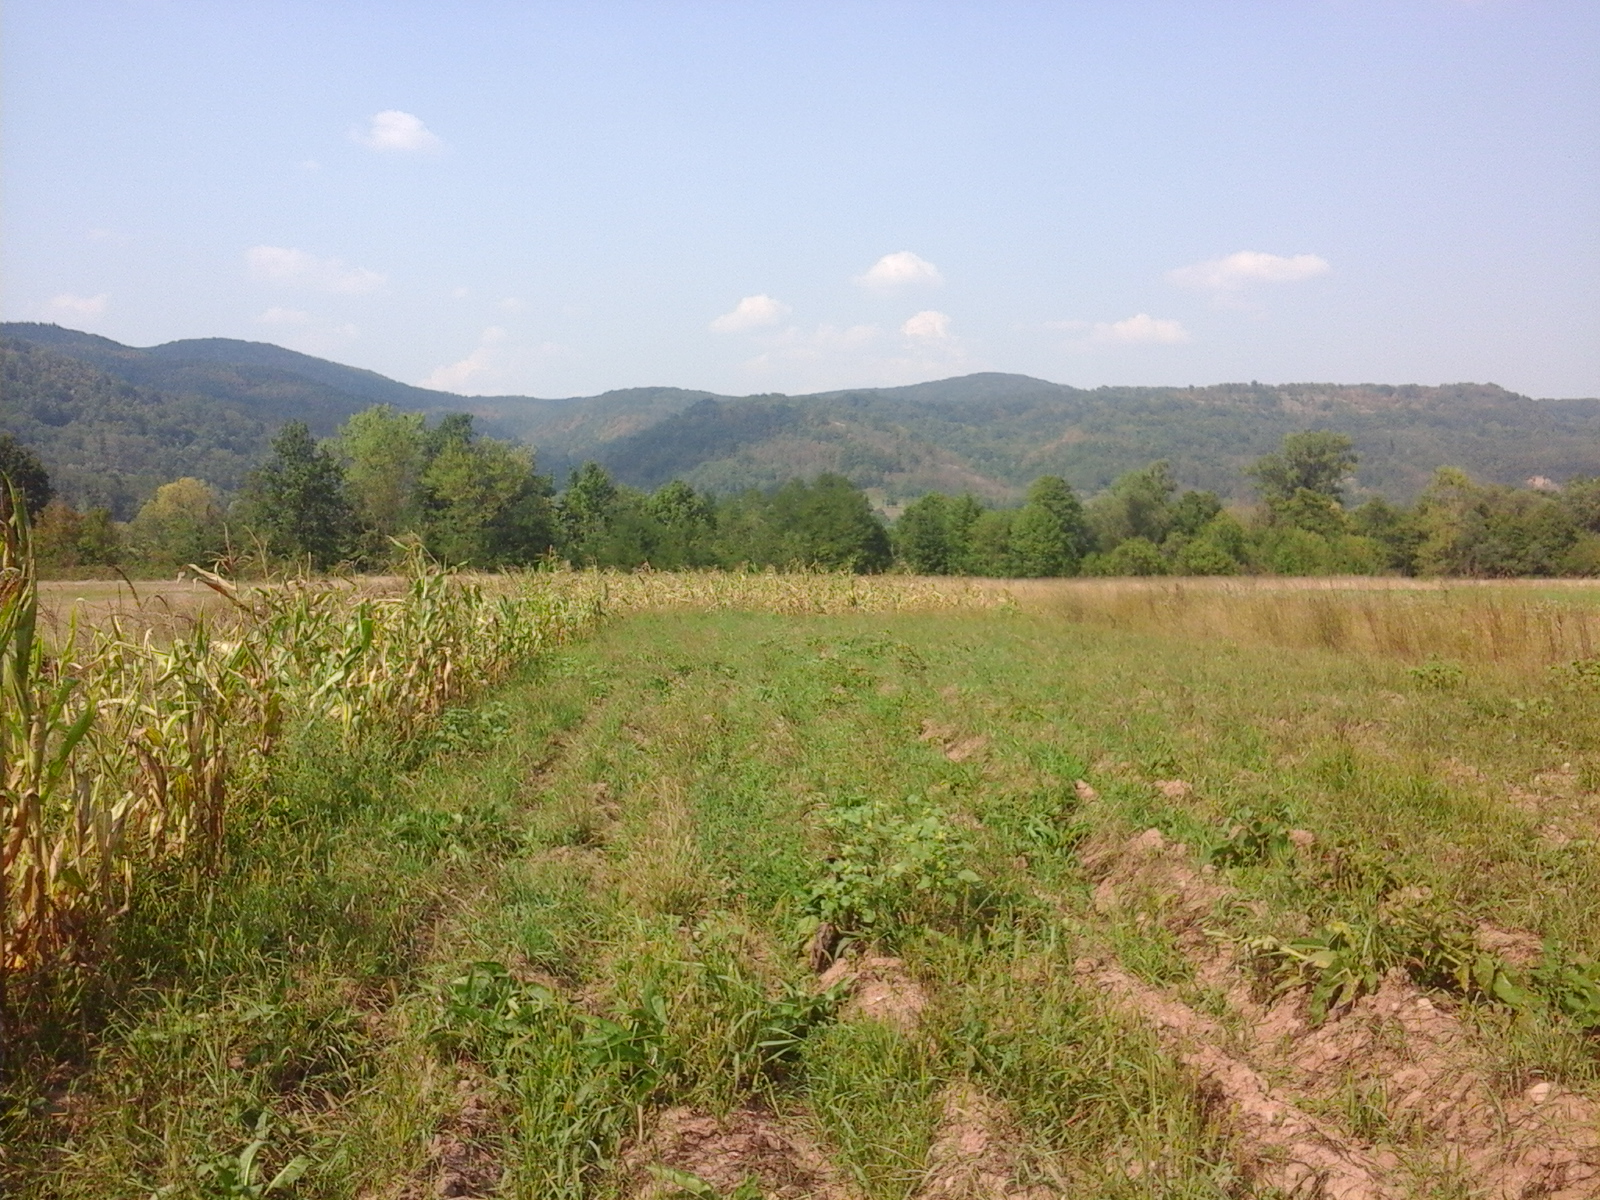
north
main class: Cropland
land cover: Potatoes
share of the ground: > 75 %
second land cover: Spontaneously vegetated surfaces
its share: > 75 %
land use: Agriculture (excluding fallow land and kitchen gardens)
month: August
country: RO
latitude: 46.2832
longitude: 22.3914
